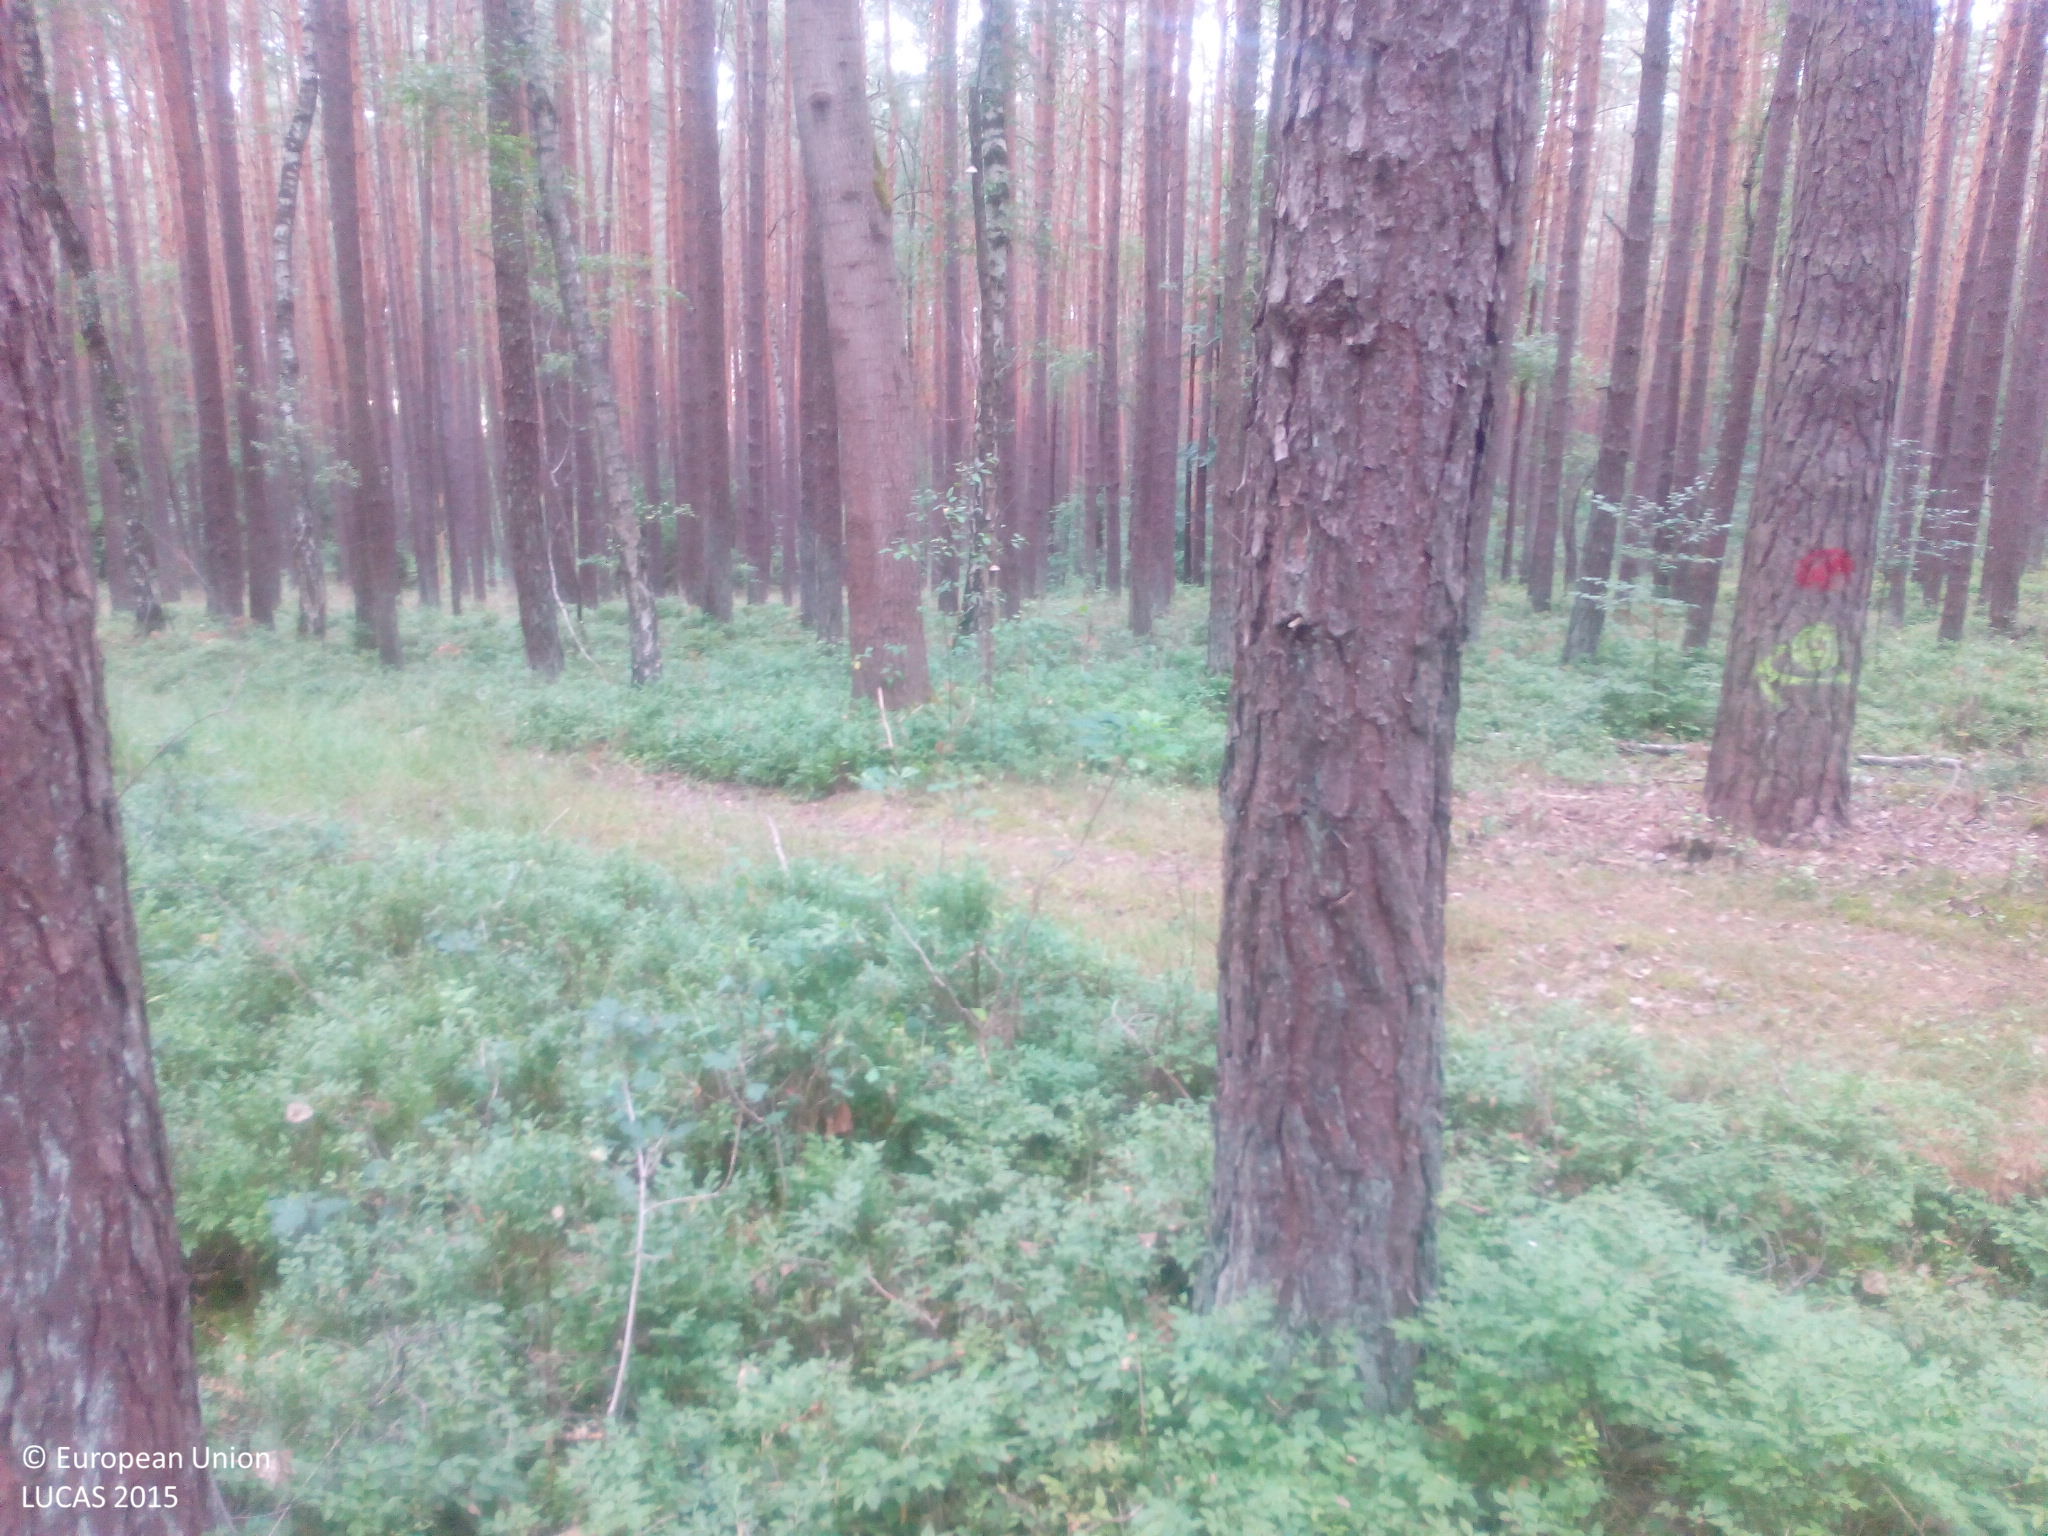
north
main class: Woodland
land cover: Pine dominated coniferous woodland
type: hemiboreal forest and nemoral coniferous forest and mixed broadleaved-coniferous forest
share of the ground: > 75 %
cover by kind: coniferous forest trees 70 %, shrubs 20 %, broadleaved forest trees 10 %
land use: Forestry
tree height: > 5 m
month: July
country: DE
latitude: 49.6052
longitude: 10.8991
